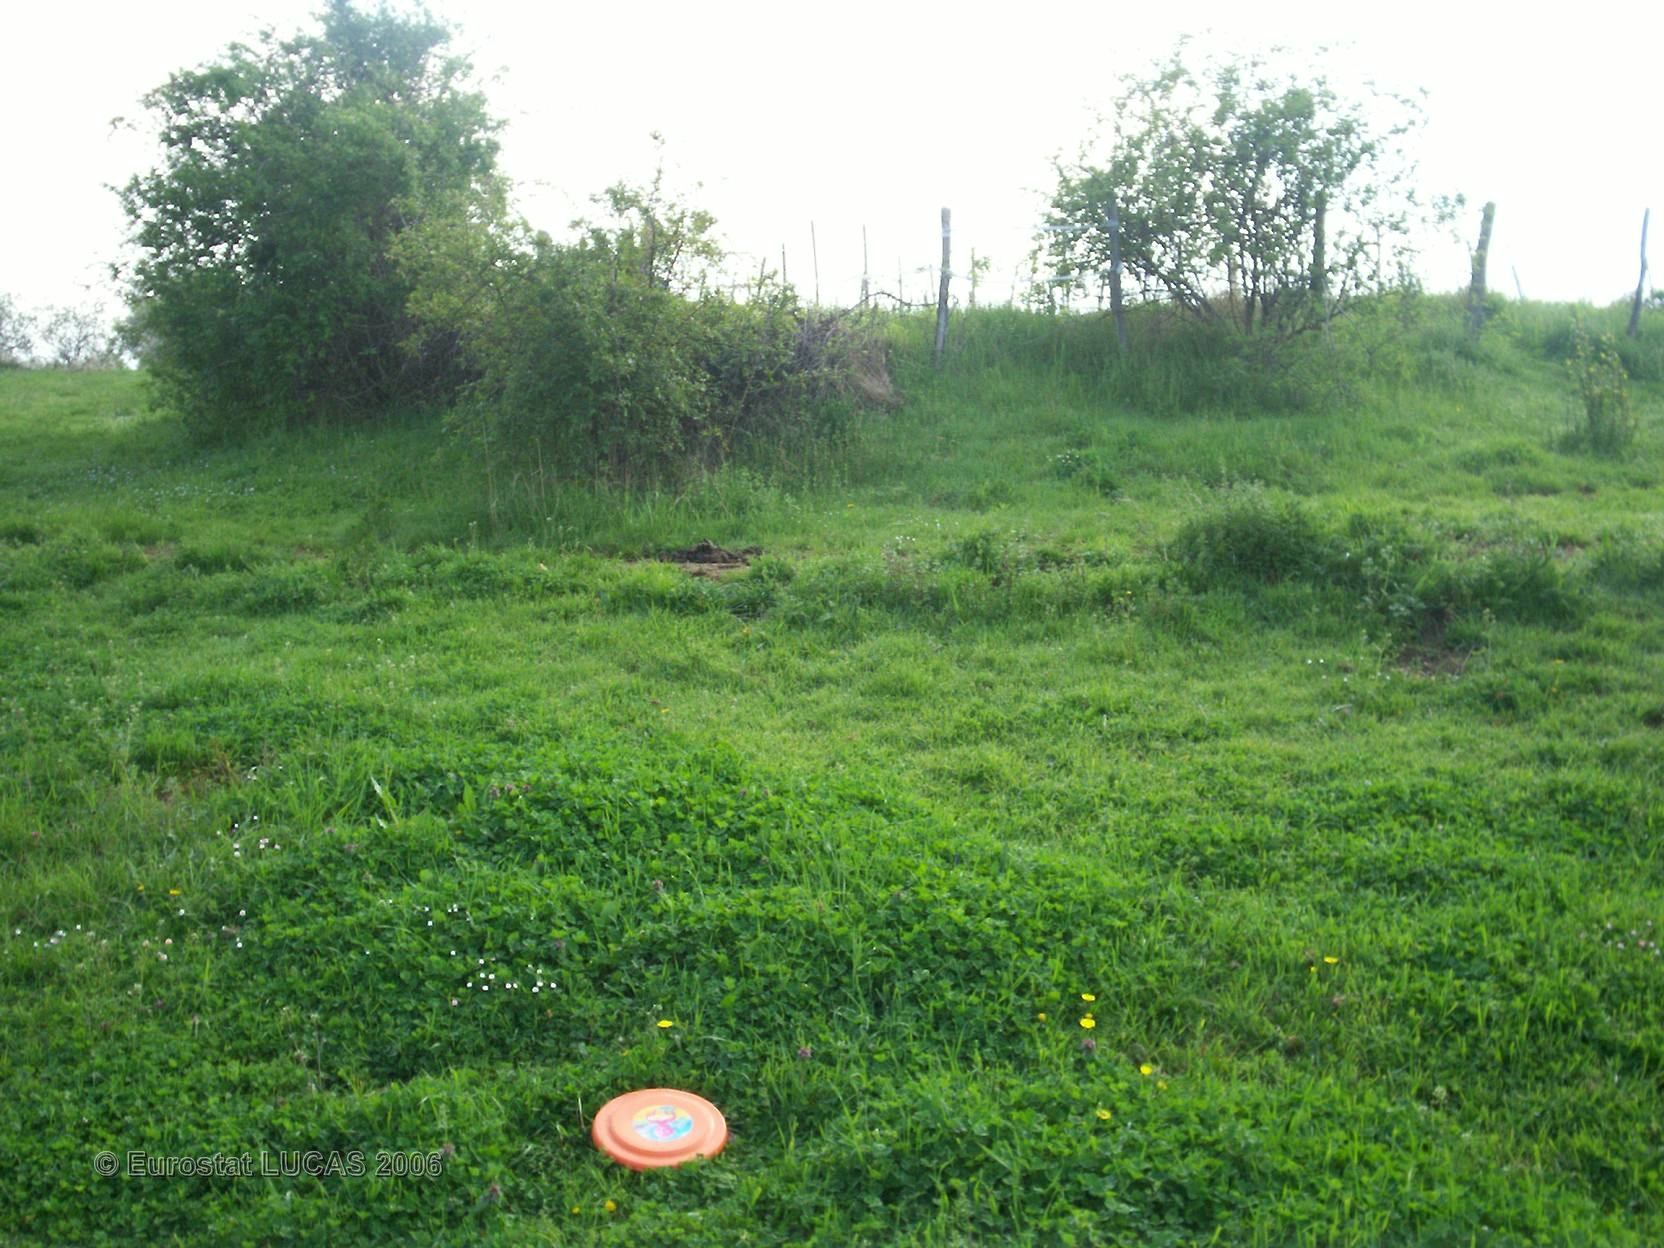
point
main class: Grassland
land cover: Grassland with sparse tree/shrub cover
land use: Agriculture (excluding fallow land and kitchen gardens)
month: April
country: FR
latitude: 45.5025
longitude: 4.7953
